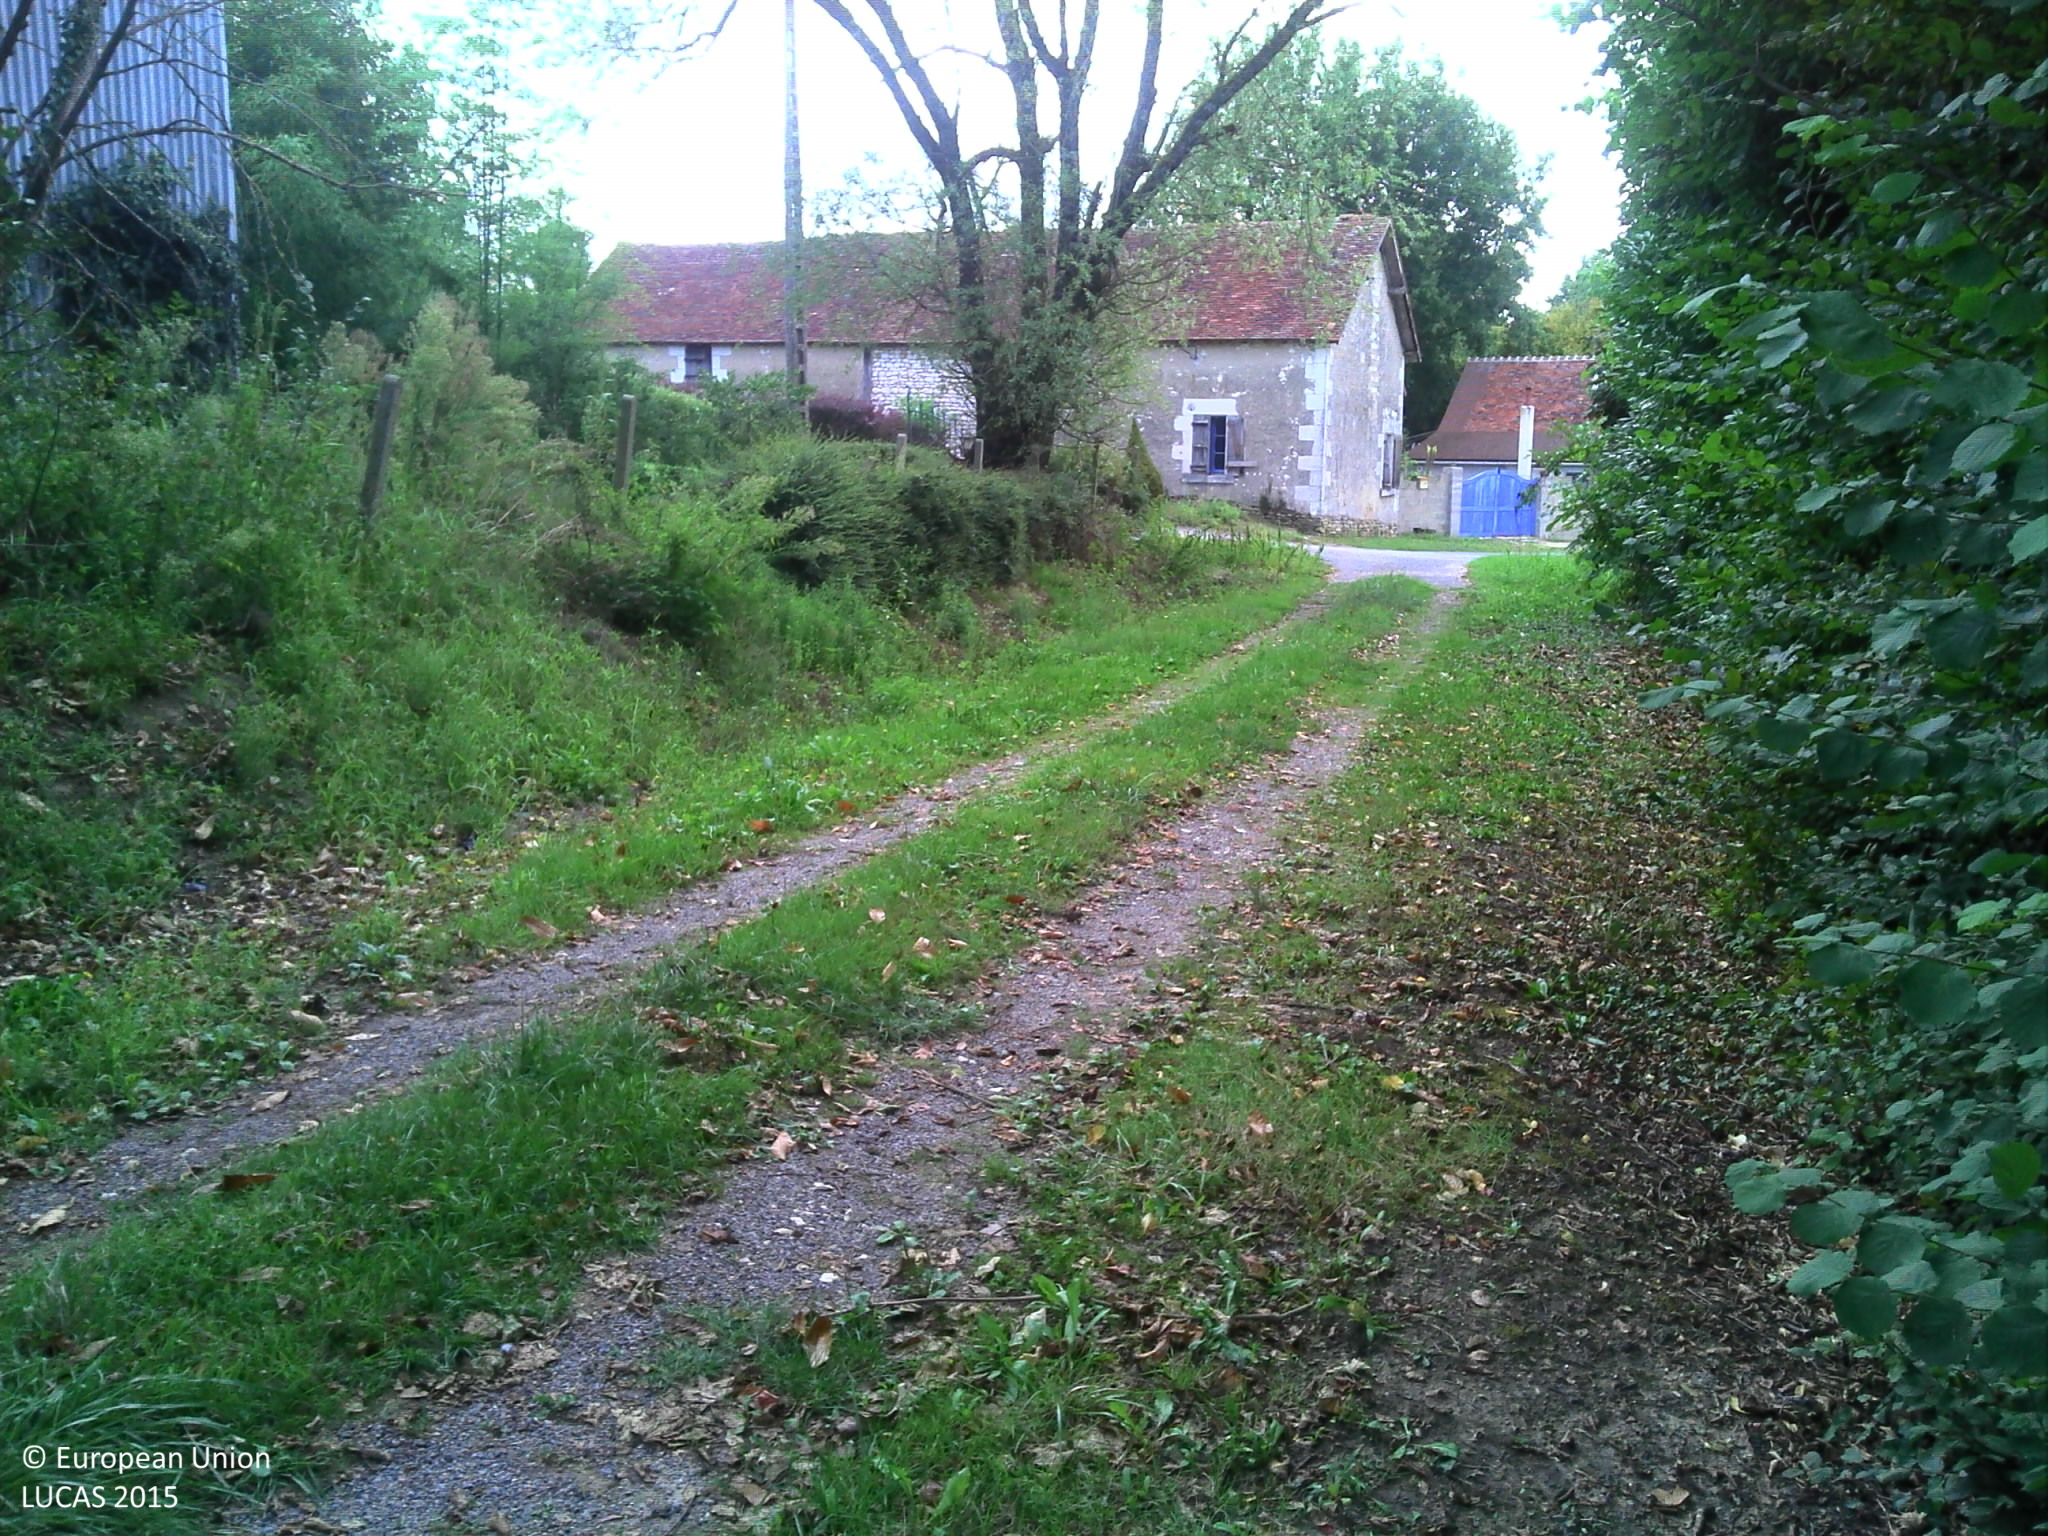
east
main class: Grassland
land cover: Grassland with sparse tree/shrub cover
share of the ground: > 75 %
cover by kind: herbaceous plants 95 %, coniferous forest trees 5 %
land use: Residential
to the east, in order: Grassland with sparse tree/shrub cover; Artificial constructions in urban areas; Grassland with sparse tree/shrub cover; Fences; Broadleaved woodland; Common wheat; Ditches and canals; Grassland without tree/shrub cover
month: September
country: FR
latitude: 46.9843
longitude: 1.4286
